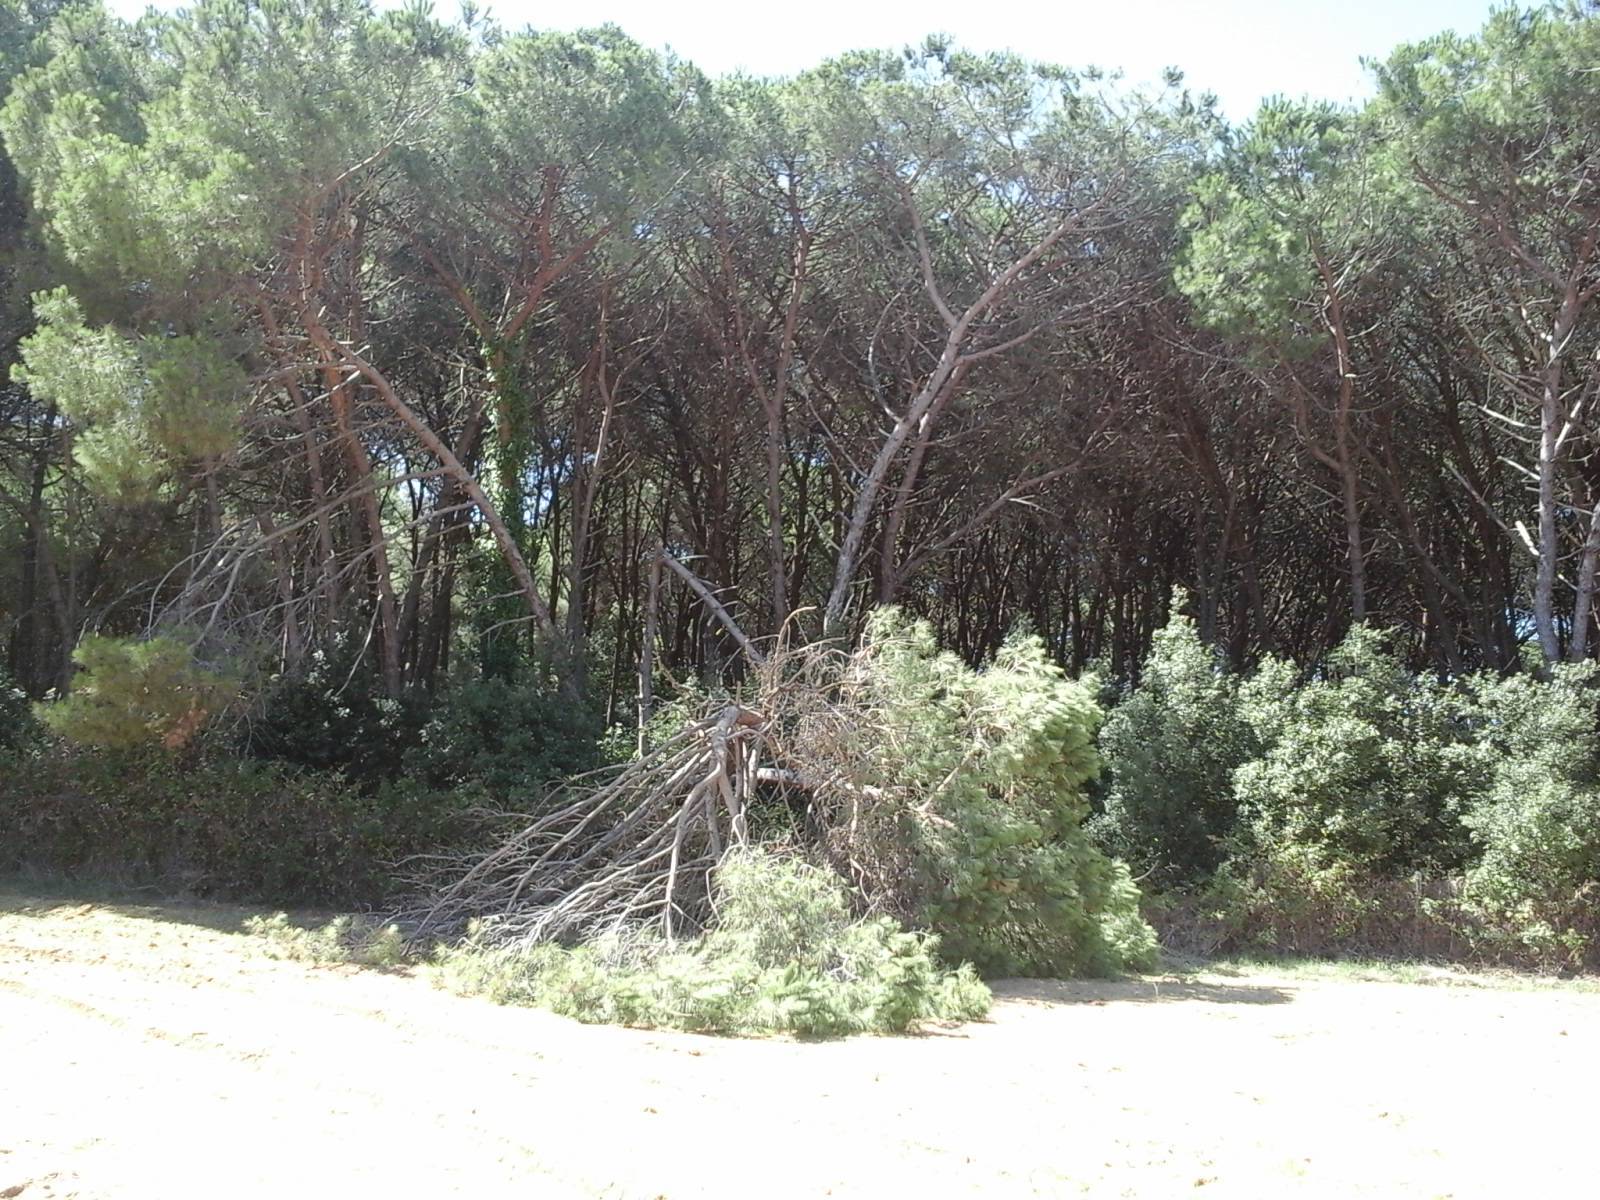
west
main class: Grassland
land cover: Spontaneously vegetated surfaces
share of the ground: > 75 %
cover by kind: herbaceous plants 100 %
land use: Agriculture (excluding fallow land and kitchen gardens)
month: August
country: IT
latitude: 41.2698
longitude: 13.0553
